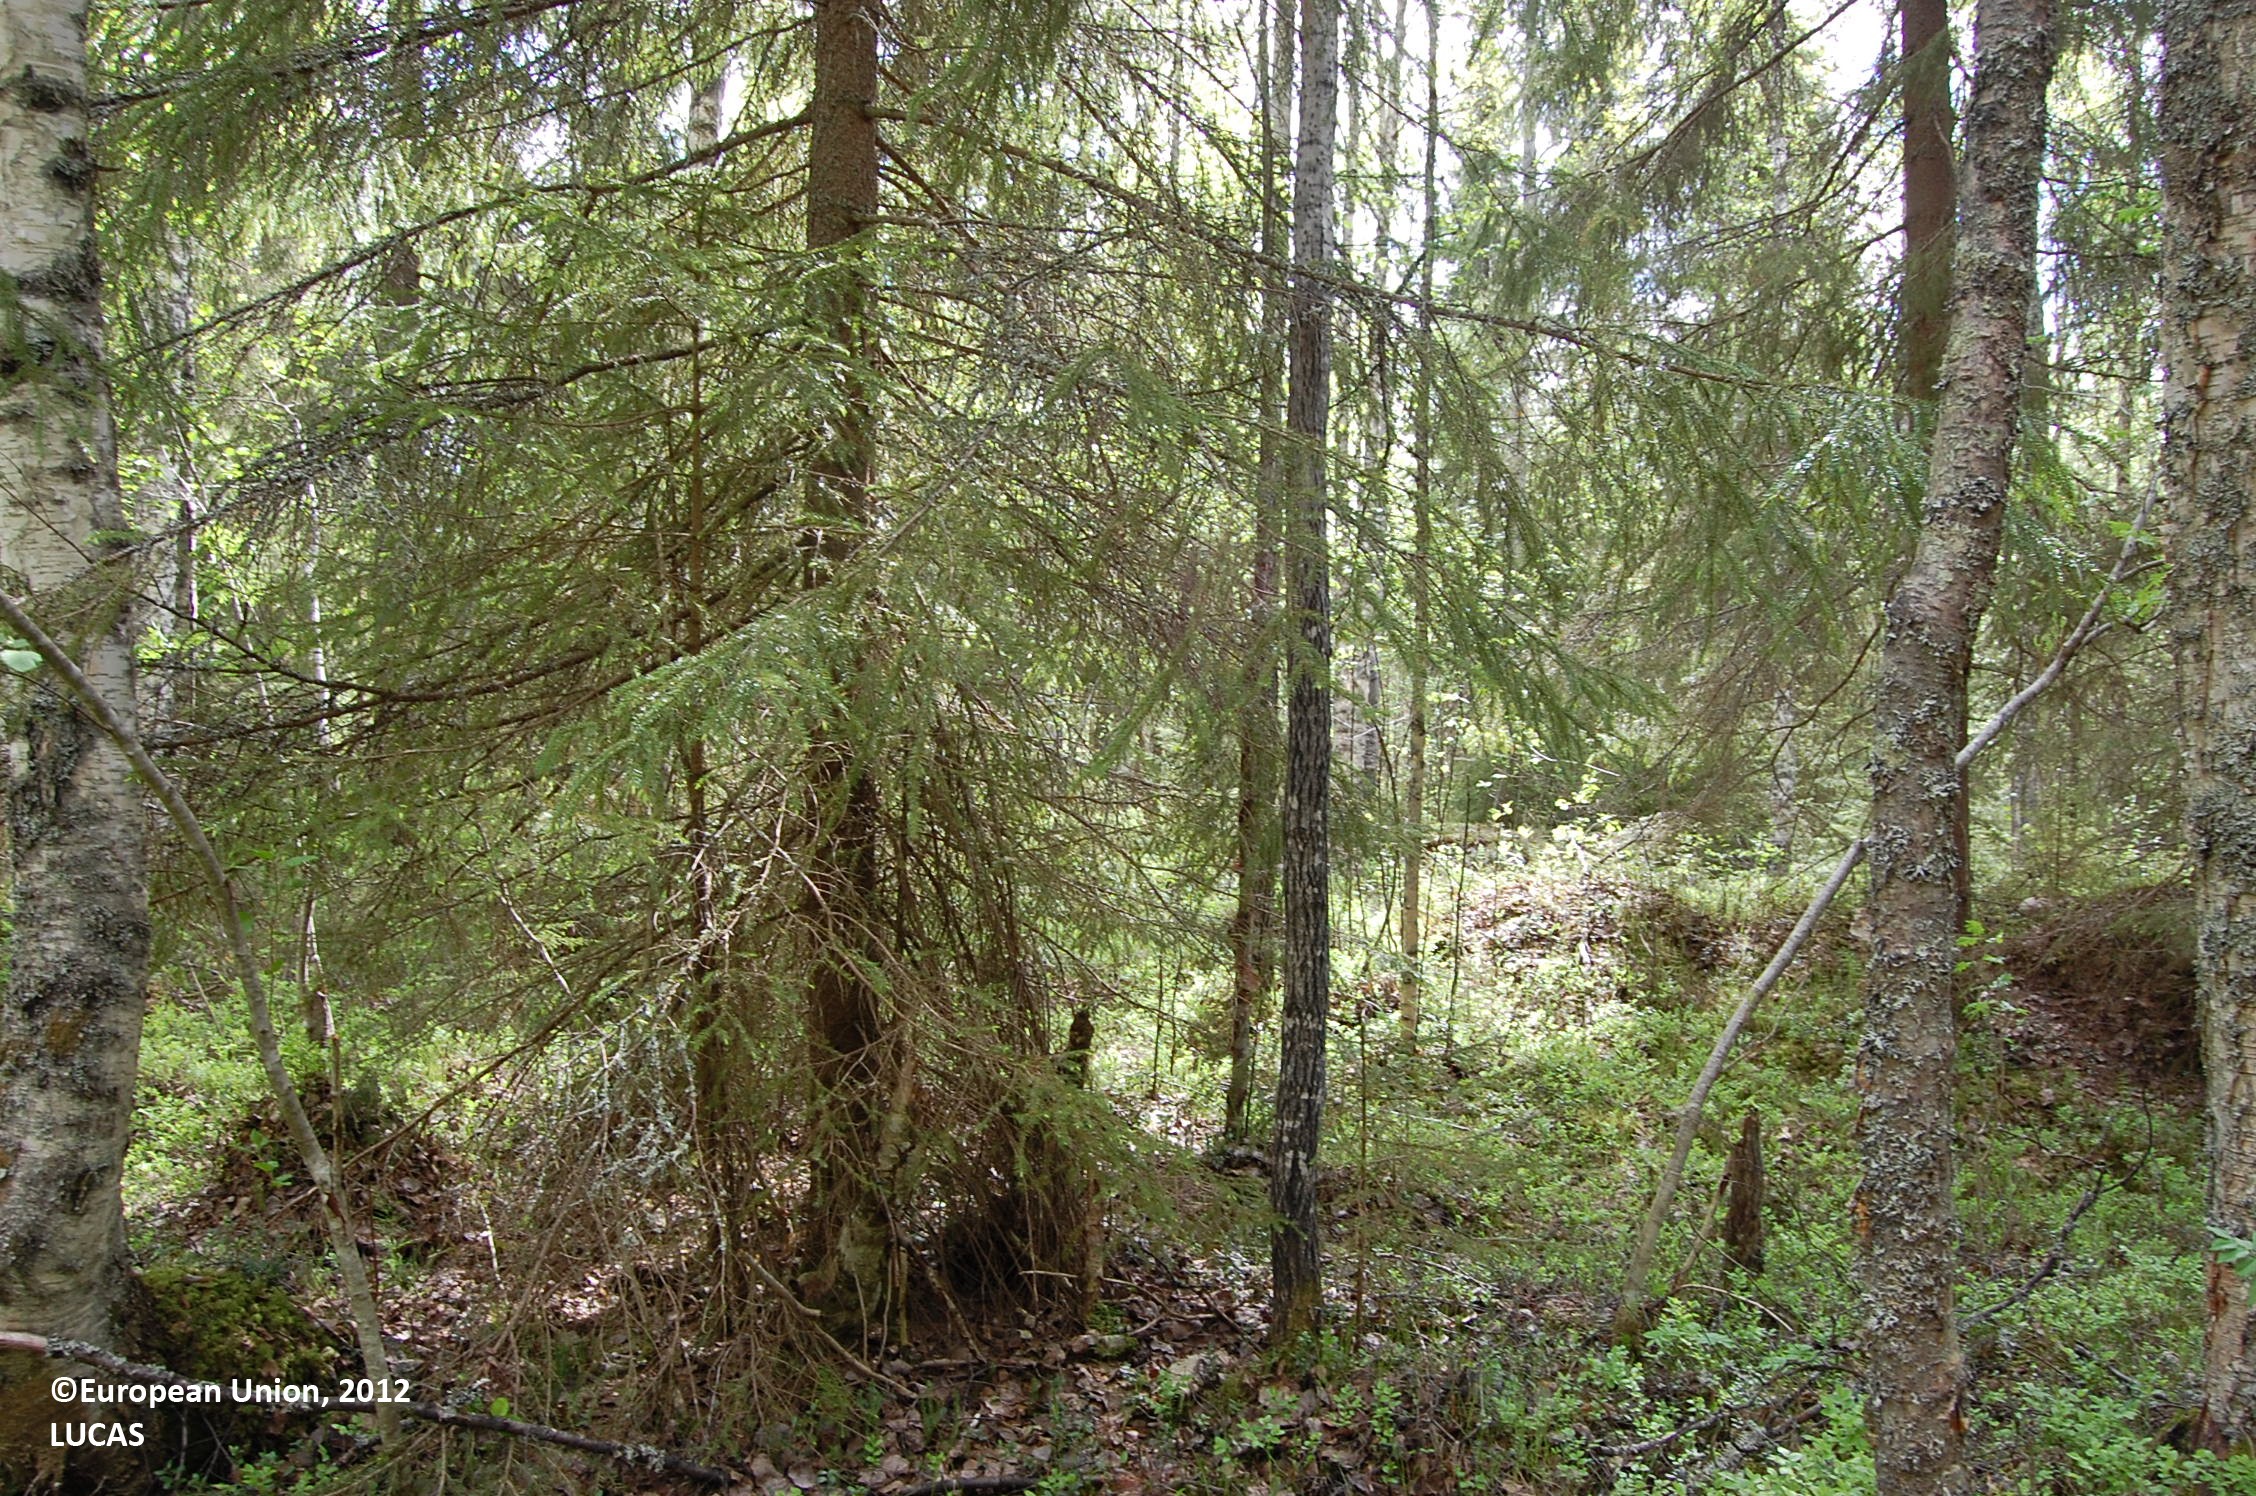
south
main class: Woodland
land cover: Spruce dominated mixed woodland
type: hemiboreal forest and nemoral coniferous forest and mixed broadleaved-coniferous forest
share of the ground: 50 - 75 %
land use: Forestry
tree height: > 5 m
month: June
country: FI
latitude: 64.0579
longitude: 26.1953
